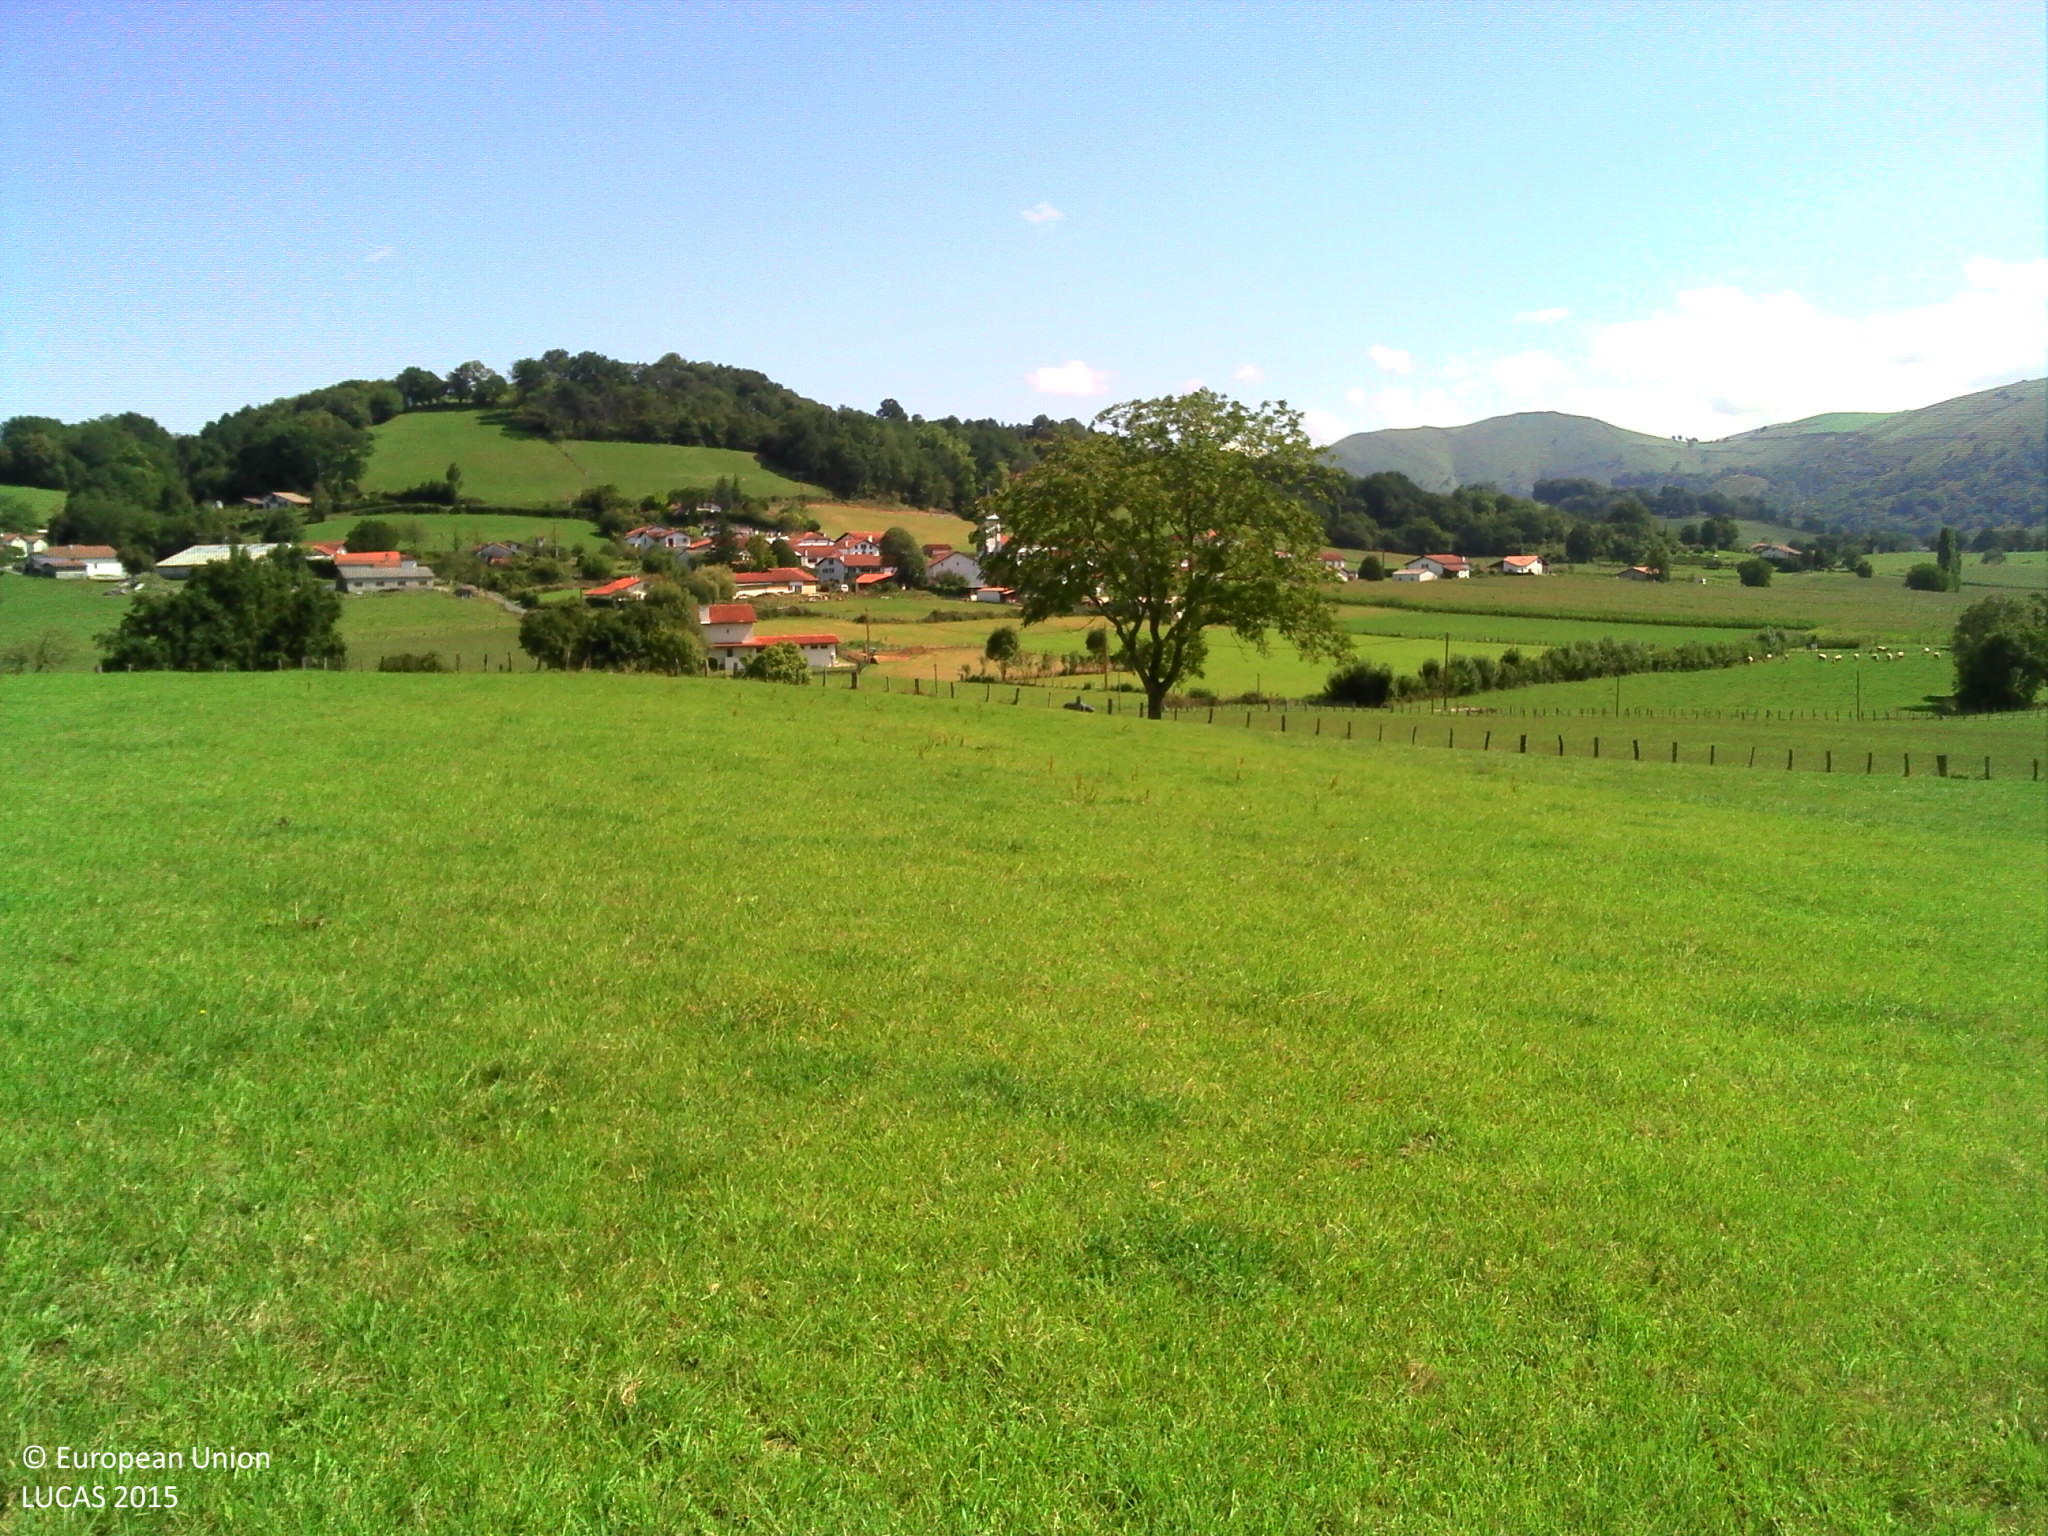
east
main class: Grassland
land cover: Grassland without tree/shrub cover
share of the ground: > 75 %
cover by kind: herbaceous plants 100 %
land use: Agriculture (excluding fallow land and kitchen gardens)
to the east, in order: Grassland without tree/shrub cover; Fences; Grassland without tree/shrub cover; Single bushes/trees; Grassland without tree/shrub cover; Fences; Electric lines; Ditches and canals; Tracks; Grassland without tree/shrub cover; Rivers and streams; Grassland without tree/shrub cover; Electric lines; Grassland without tree/shrub cover
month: September
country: FR
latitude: 43.1963
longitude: -1.1994
